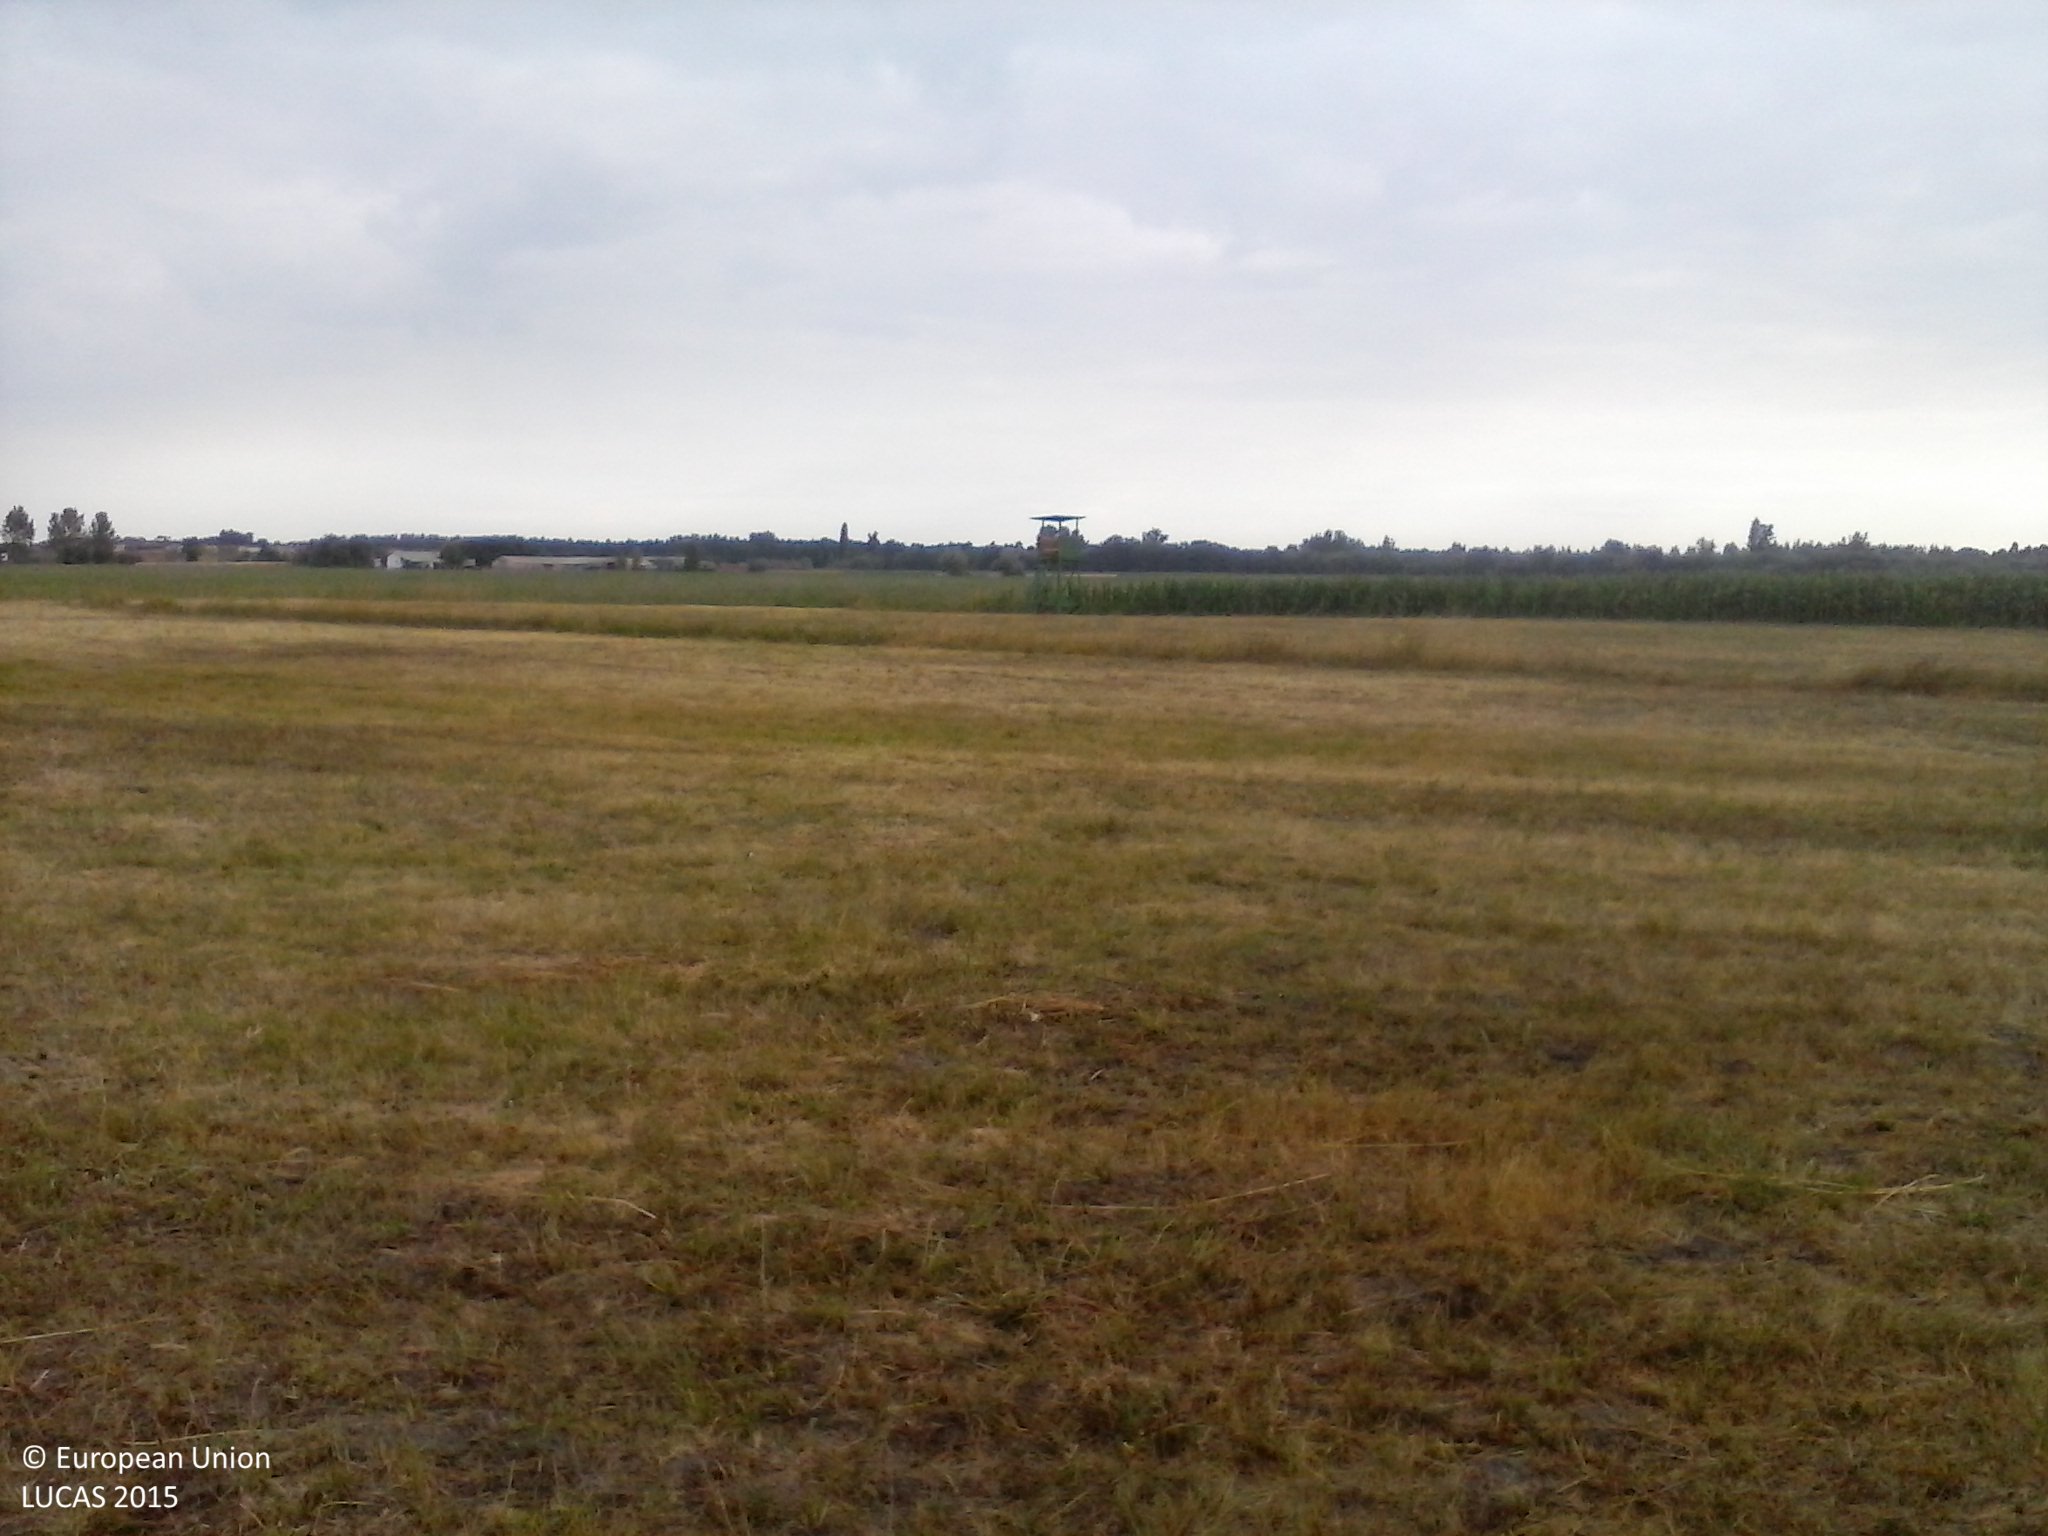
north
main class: Grassland
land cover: Grassland without tree/shrub cover
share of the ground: > 75 %
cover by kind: herbaceous plants 100 %
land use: Agriculture (excluding fallow land and kitchen gardens)
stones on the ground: < 10 %
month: July
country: HU
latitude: 46.4836
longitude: 19.5662
